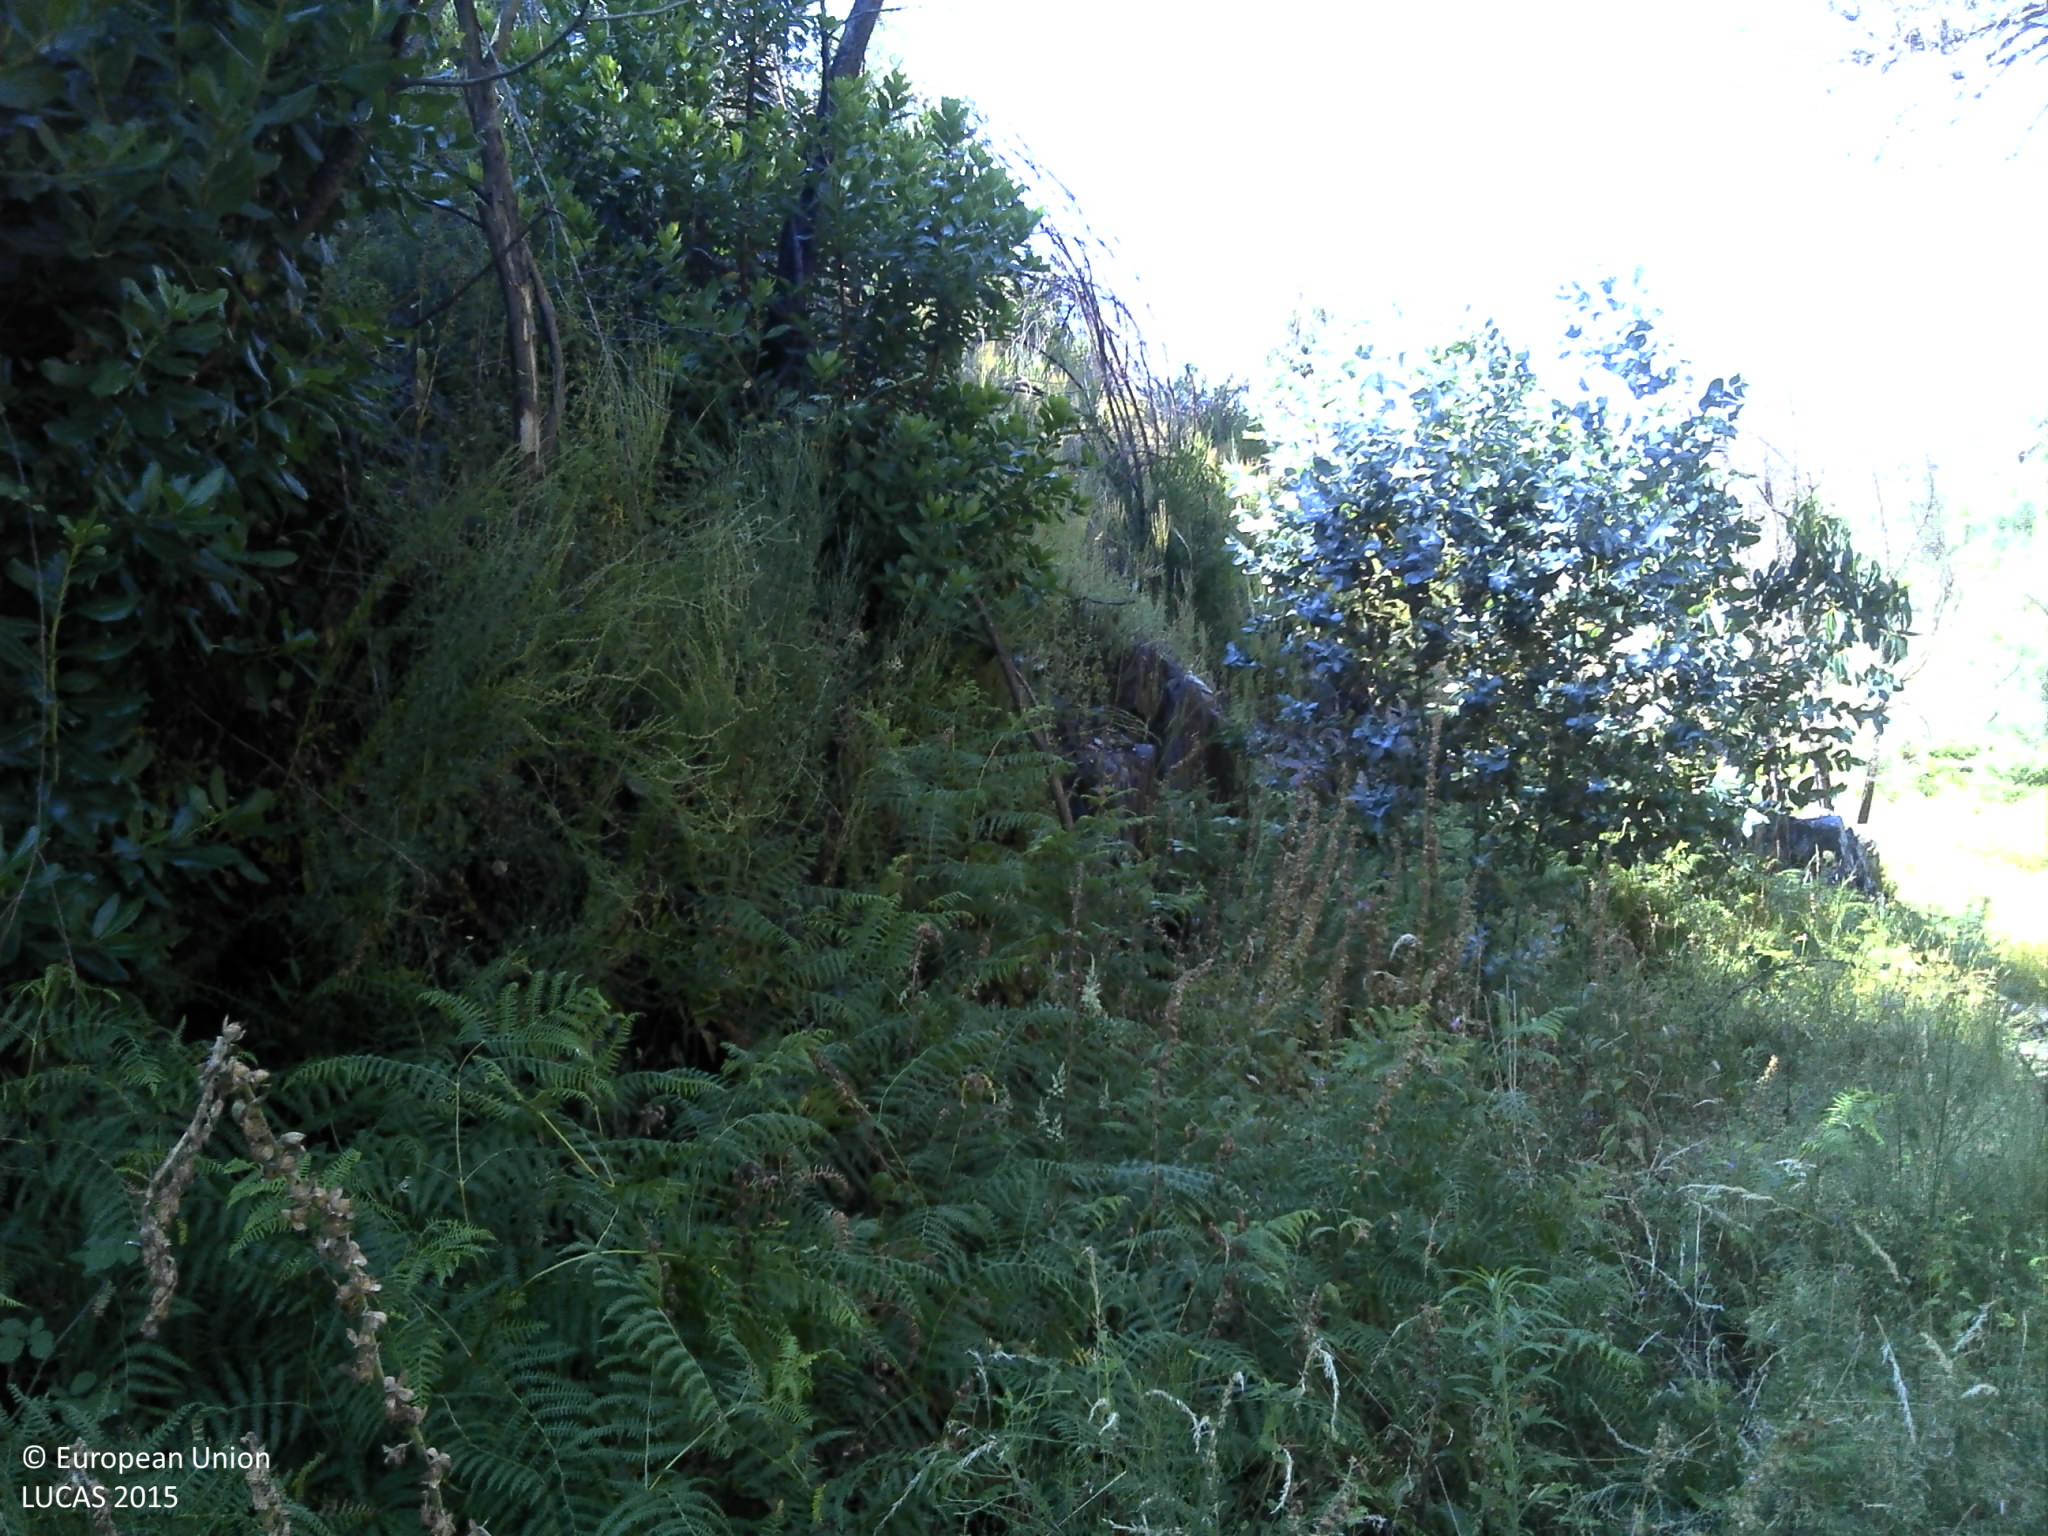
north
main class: Shrubland
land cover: Shrubland with sparse tree cover
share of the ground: > 75 %
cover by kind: shrubs 80 %, unconsolidated bare surface 15 %, broadleaved forest trees 5 %
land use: Abandoned areas
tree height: < 5 m
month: June
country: PT
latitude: 40.0489
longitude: -8.0876
